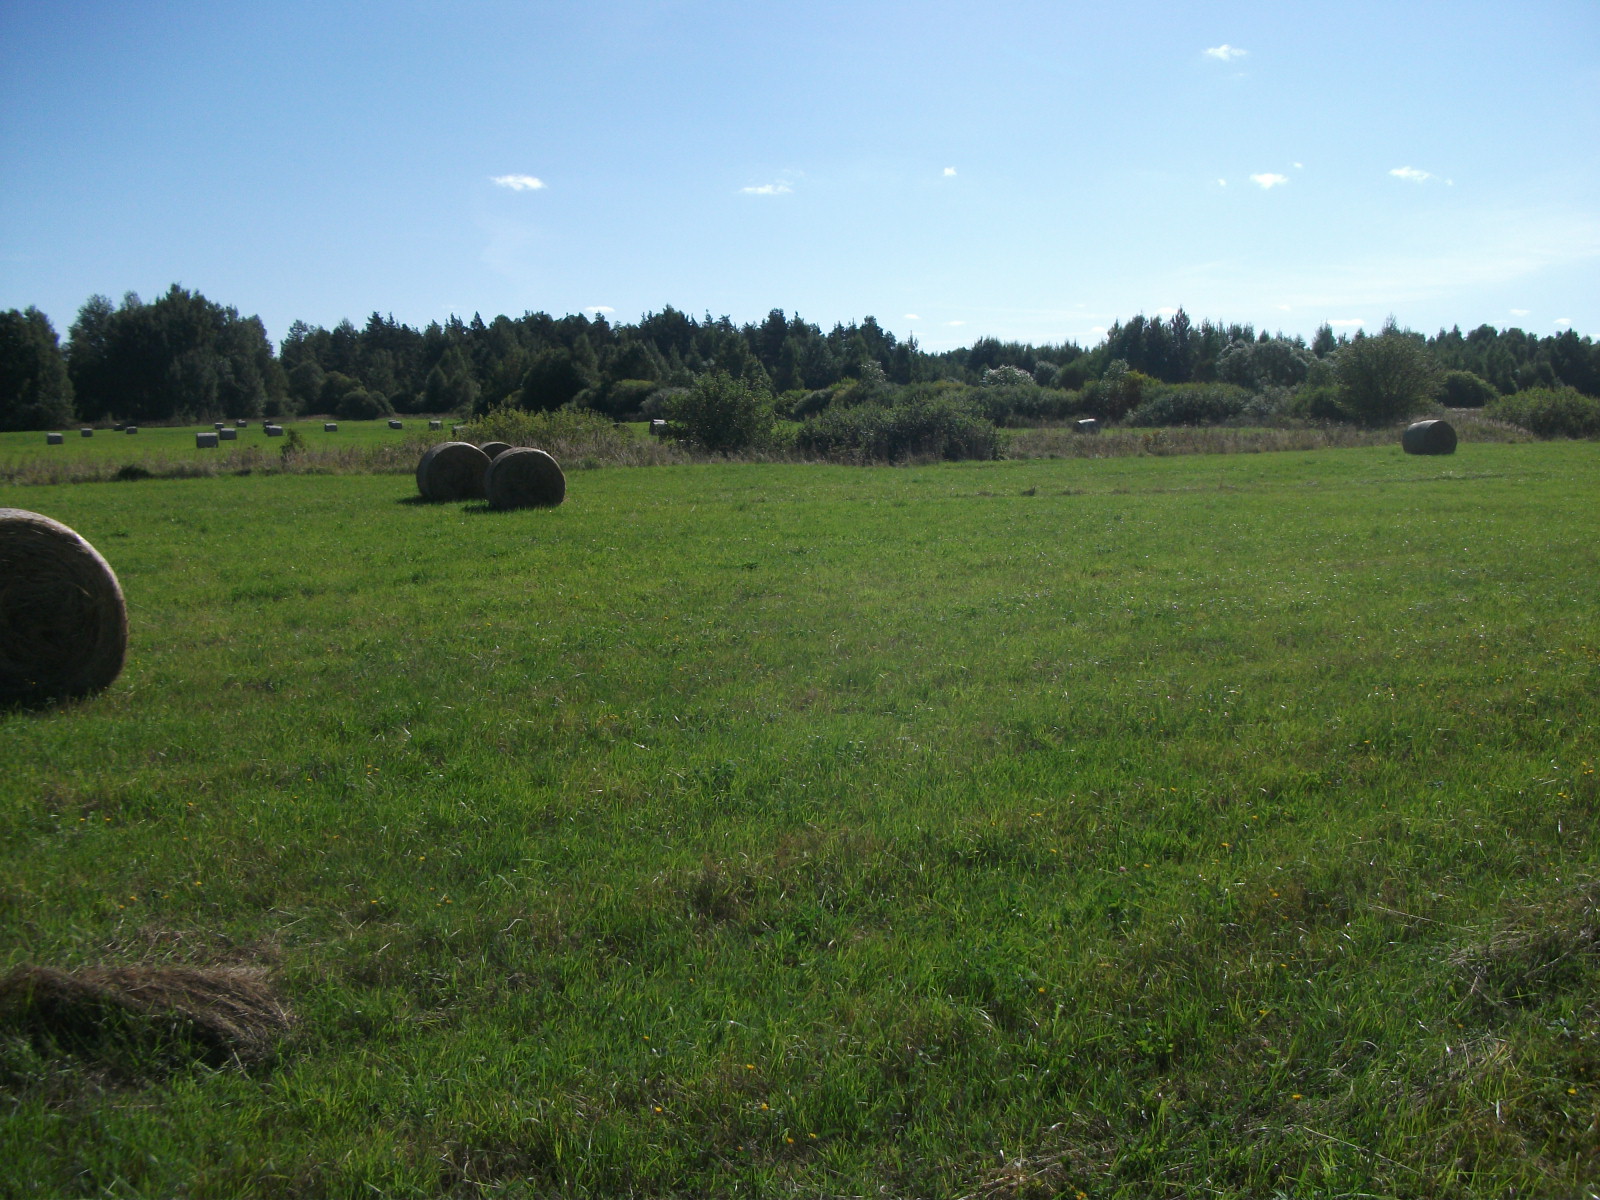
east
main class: Grassland
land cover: Grassland without tree/shrub cover
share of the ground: > 75 %
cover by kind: herbaceous plants 100 %
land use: Agriculture (excluding fallow land and kitchen gardens)
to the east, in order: Grassland without tree/shrub cover; Abandoned hedges; Ditches and canals; Abandoned hedges; Grassland without tree/shrub cover
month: August
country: LV
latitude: 56.3304
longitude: 26.2998
